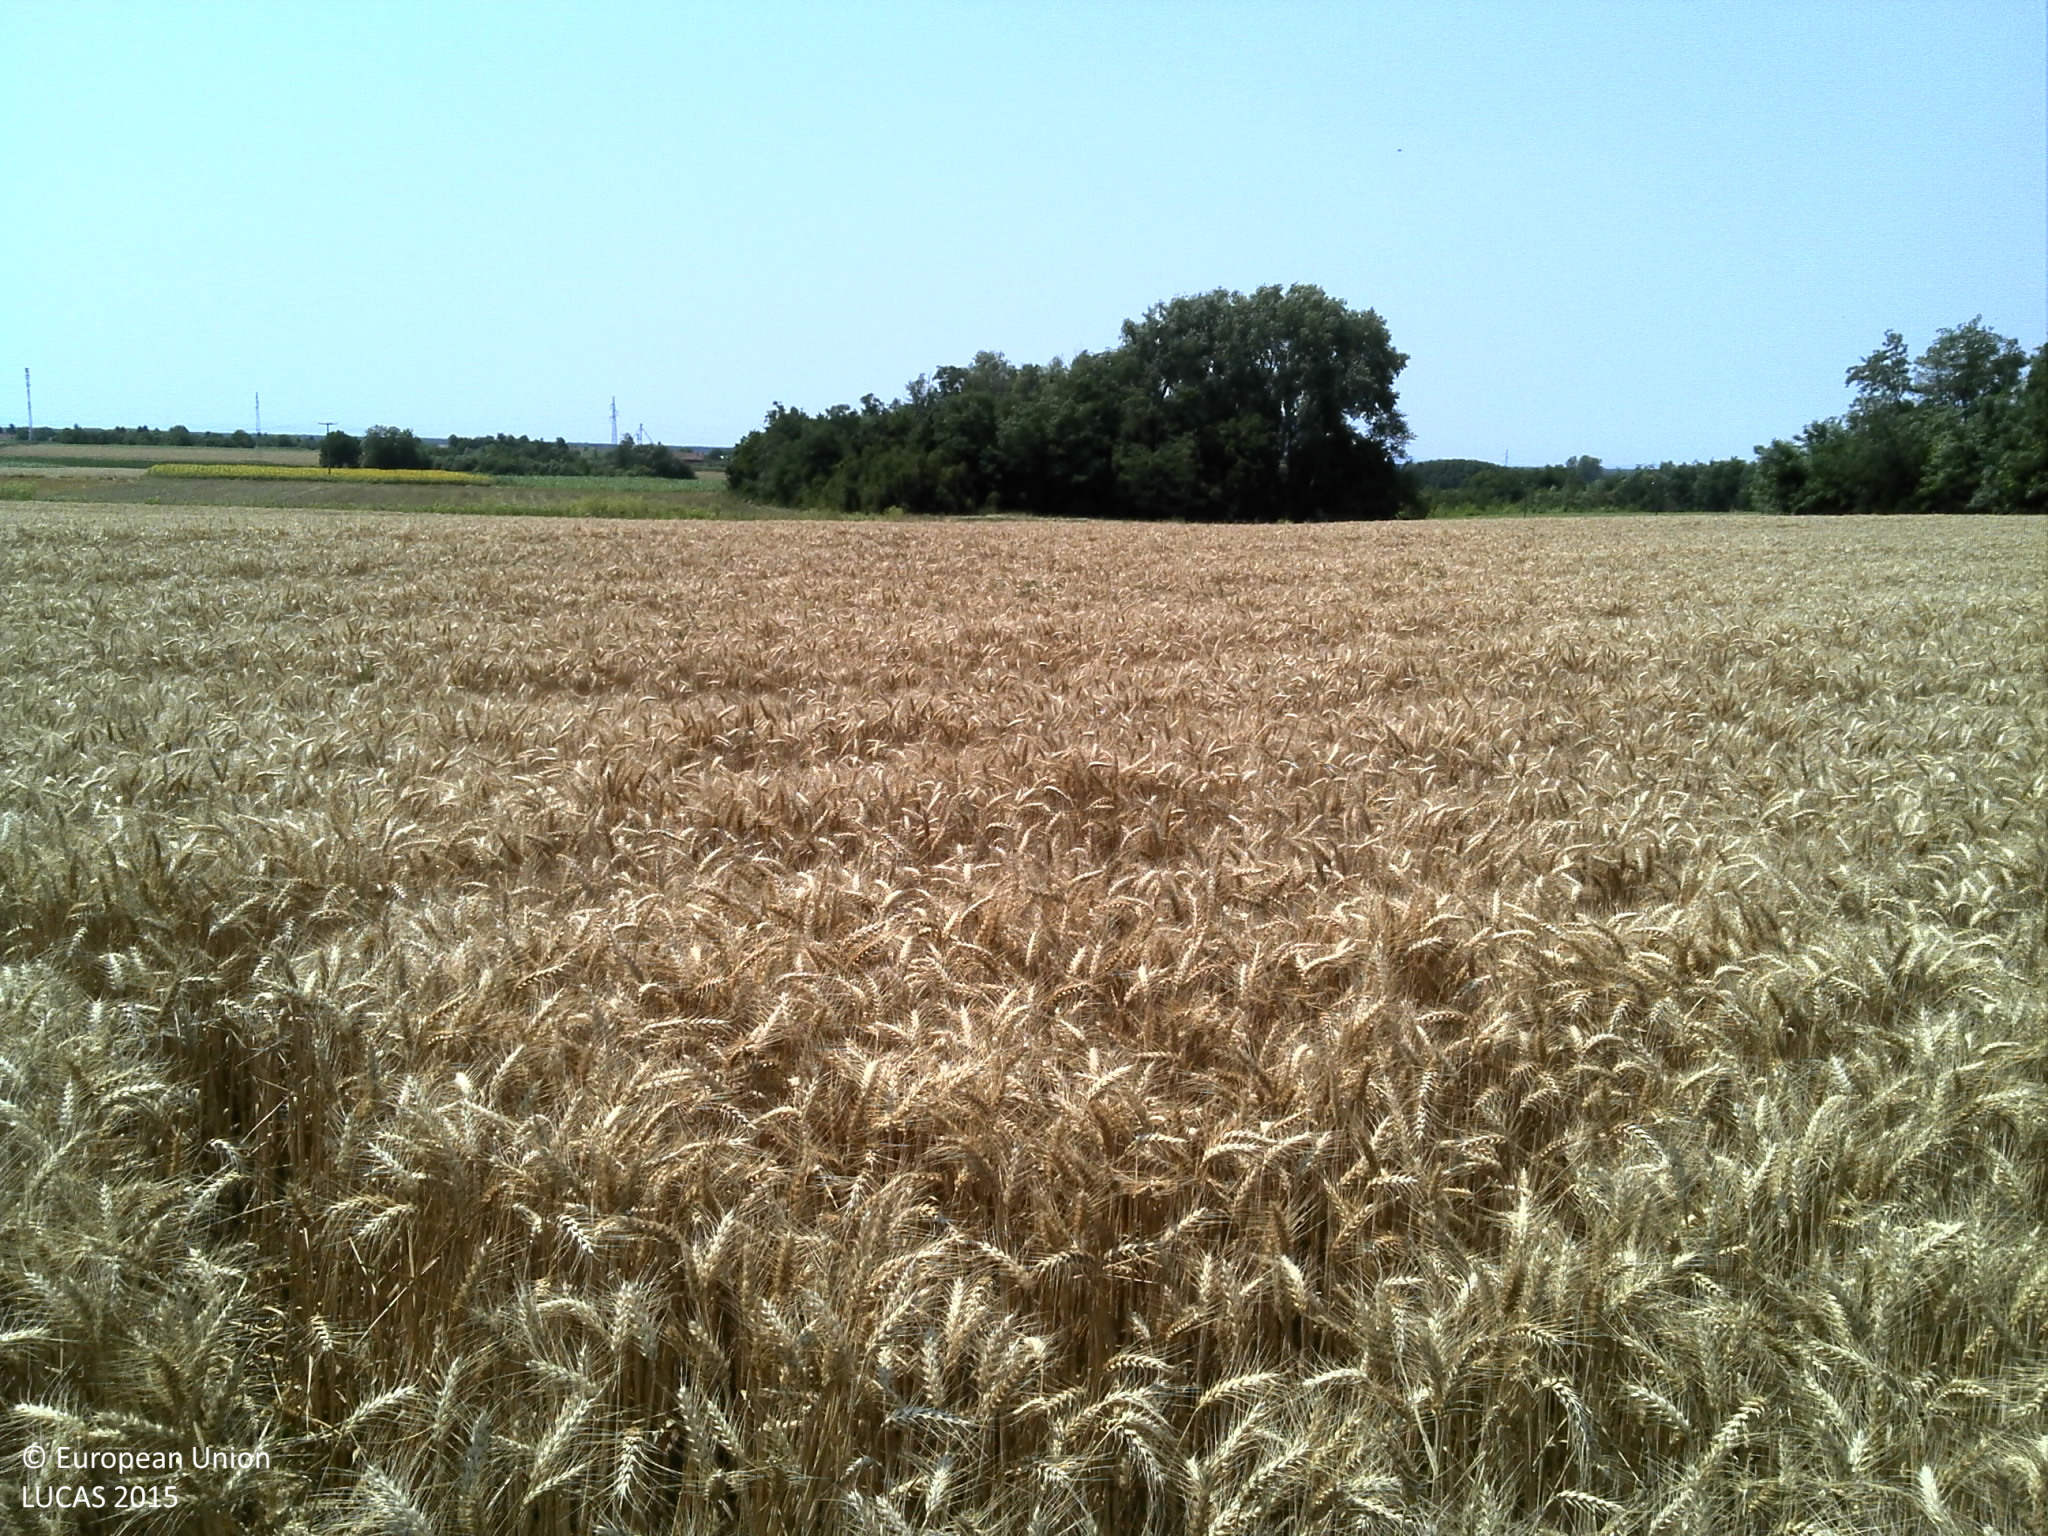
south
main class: Cropland
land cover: Common wheat
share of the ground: > 75 %
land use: Agriculture (excluding fallow land and kitchen gardens)
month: July
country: HR
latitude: 45.3010
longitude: 18.5630
